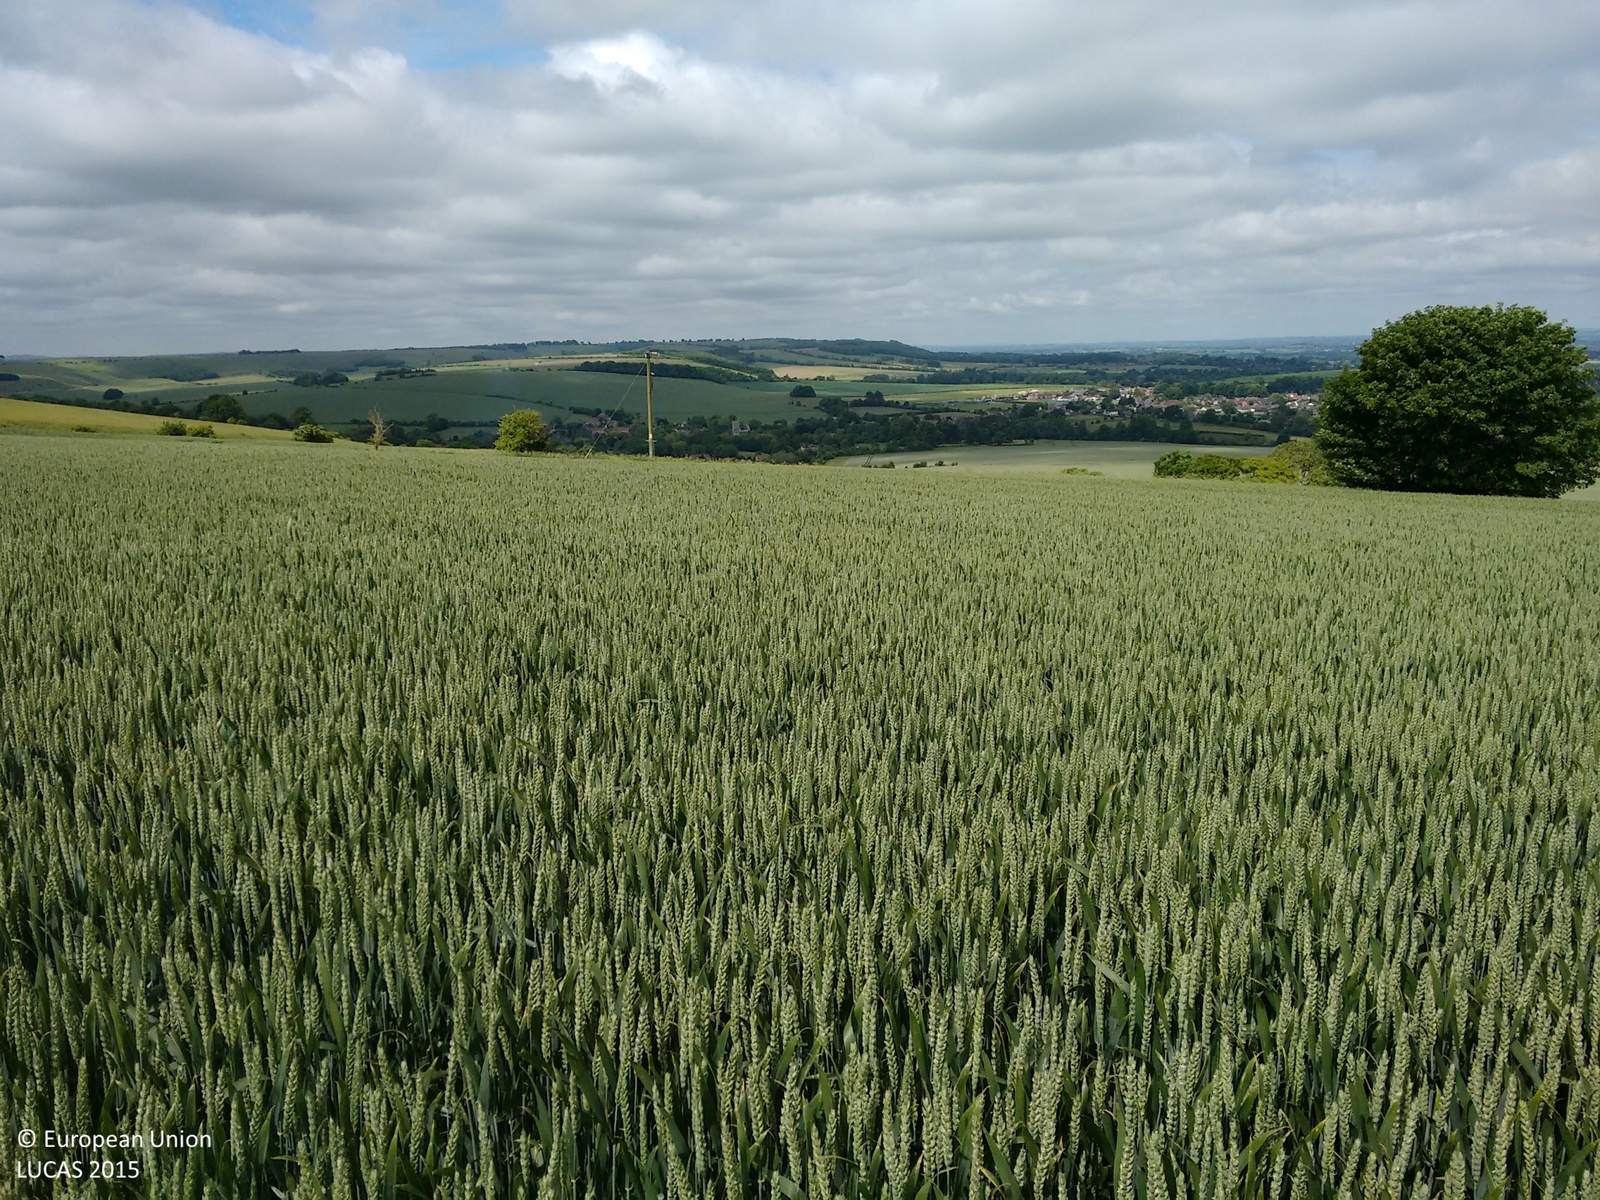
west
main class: Cropland
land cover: Common wheat
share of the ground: > 75 %
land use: Agriculture (excluding fallow land and kitchen gardens)
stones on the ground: 25 - 50 %
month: June
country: GB
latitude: 51.2781
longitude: -1.9711
